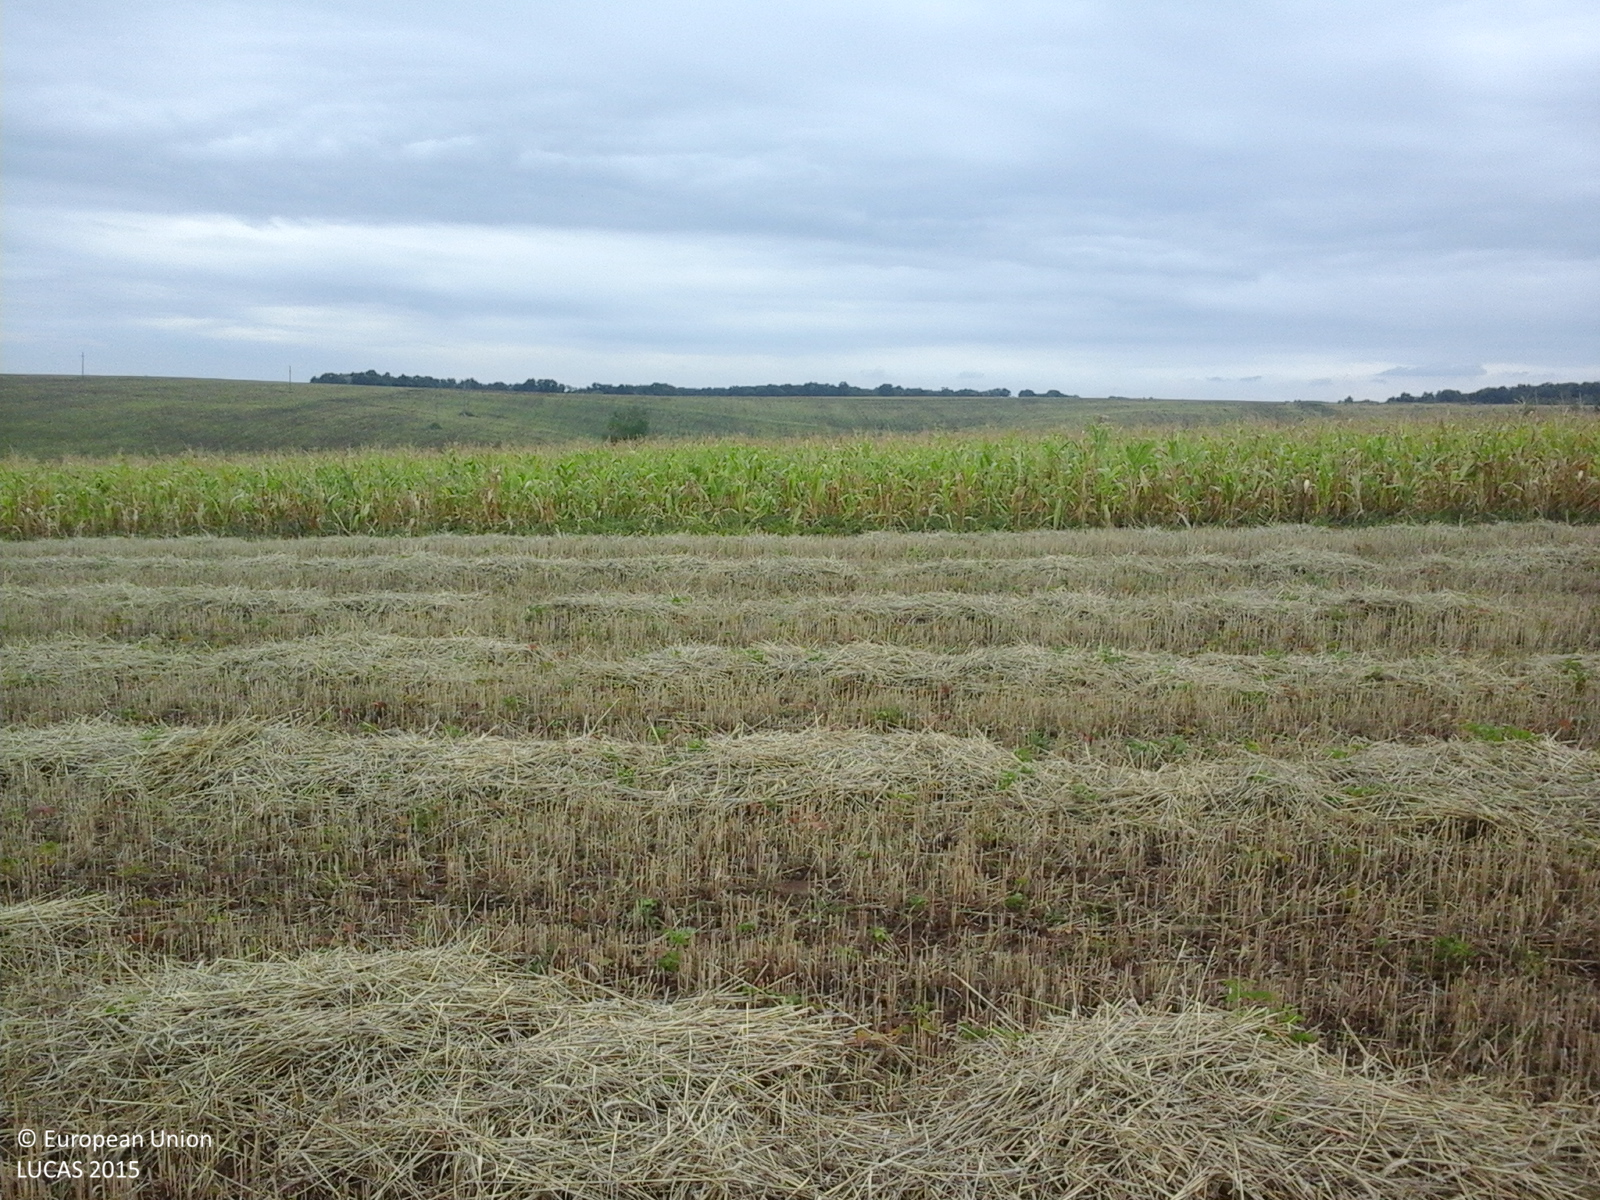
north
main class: Cropland
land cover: Durum wheat
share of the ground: > 75 %
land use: Agriculture (excluding fallow land and kitchen gardens)
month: August
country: RO
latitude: 45.8728
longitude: 21.5133
